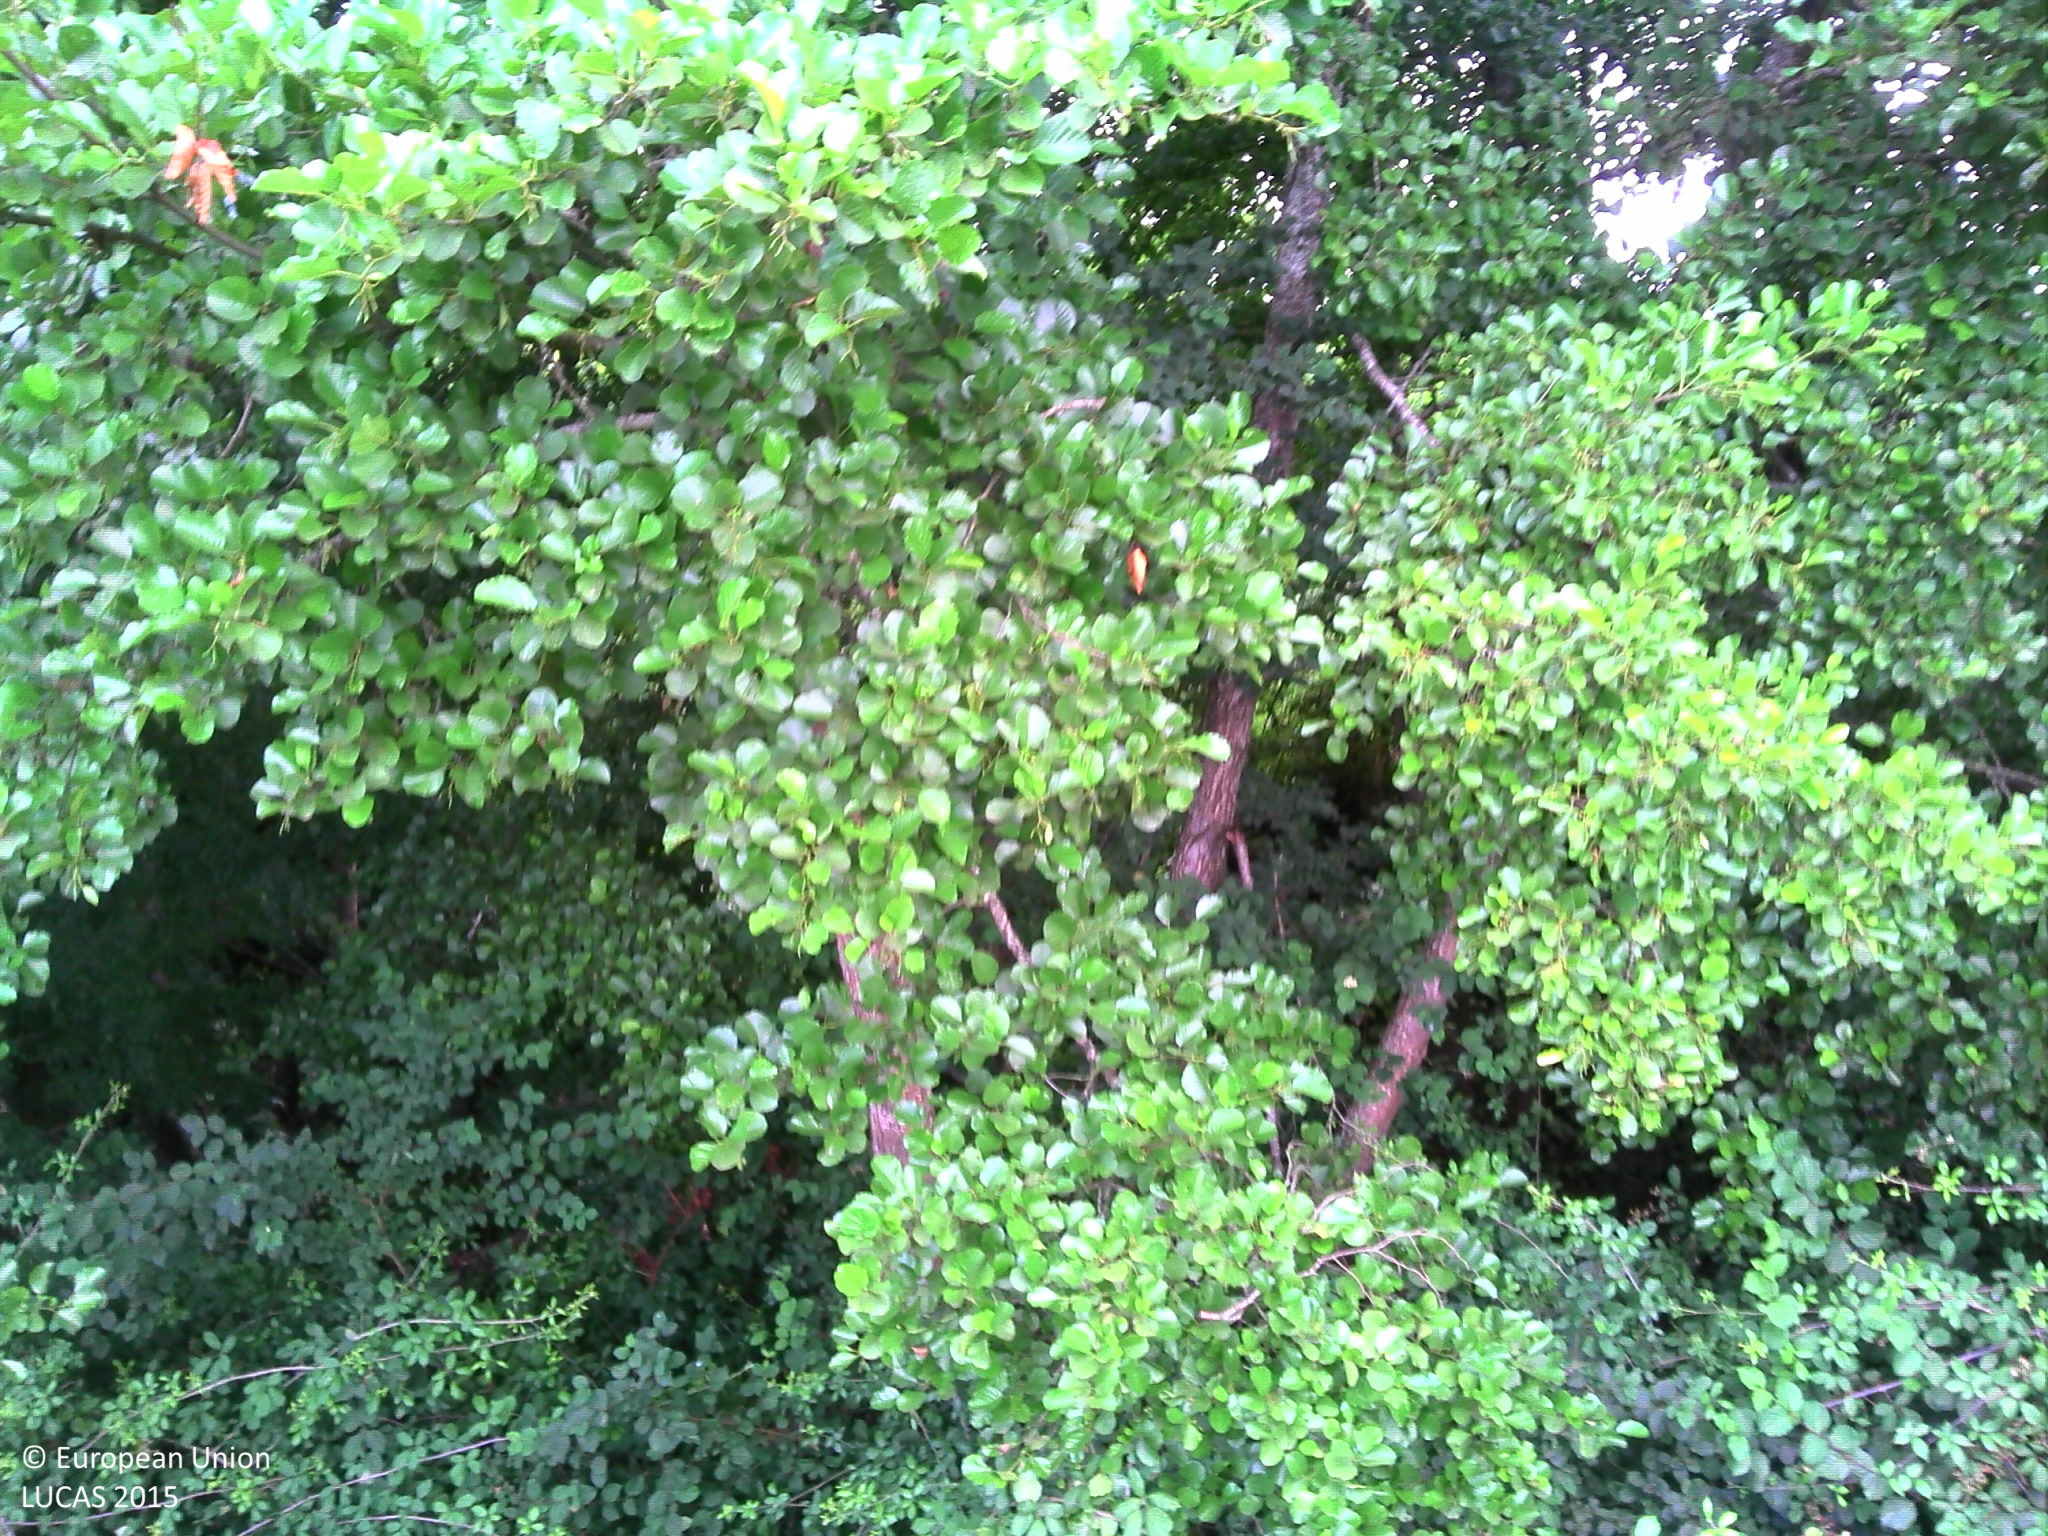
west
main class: Grassland
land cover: Spontaneously vegetated surfaces
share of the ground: > 75 %
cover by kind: unconsolidated bare surface 60 %, herbaceous plants 40 %
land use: Abandoned areas
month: July
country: FR
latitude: 44.4186
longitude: 0.6620
